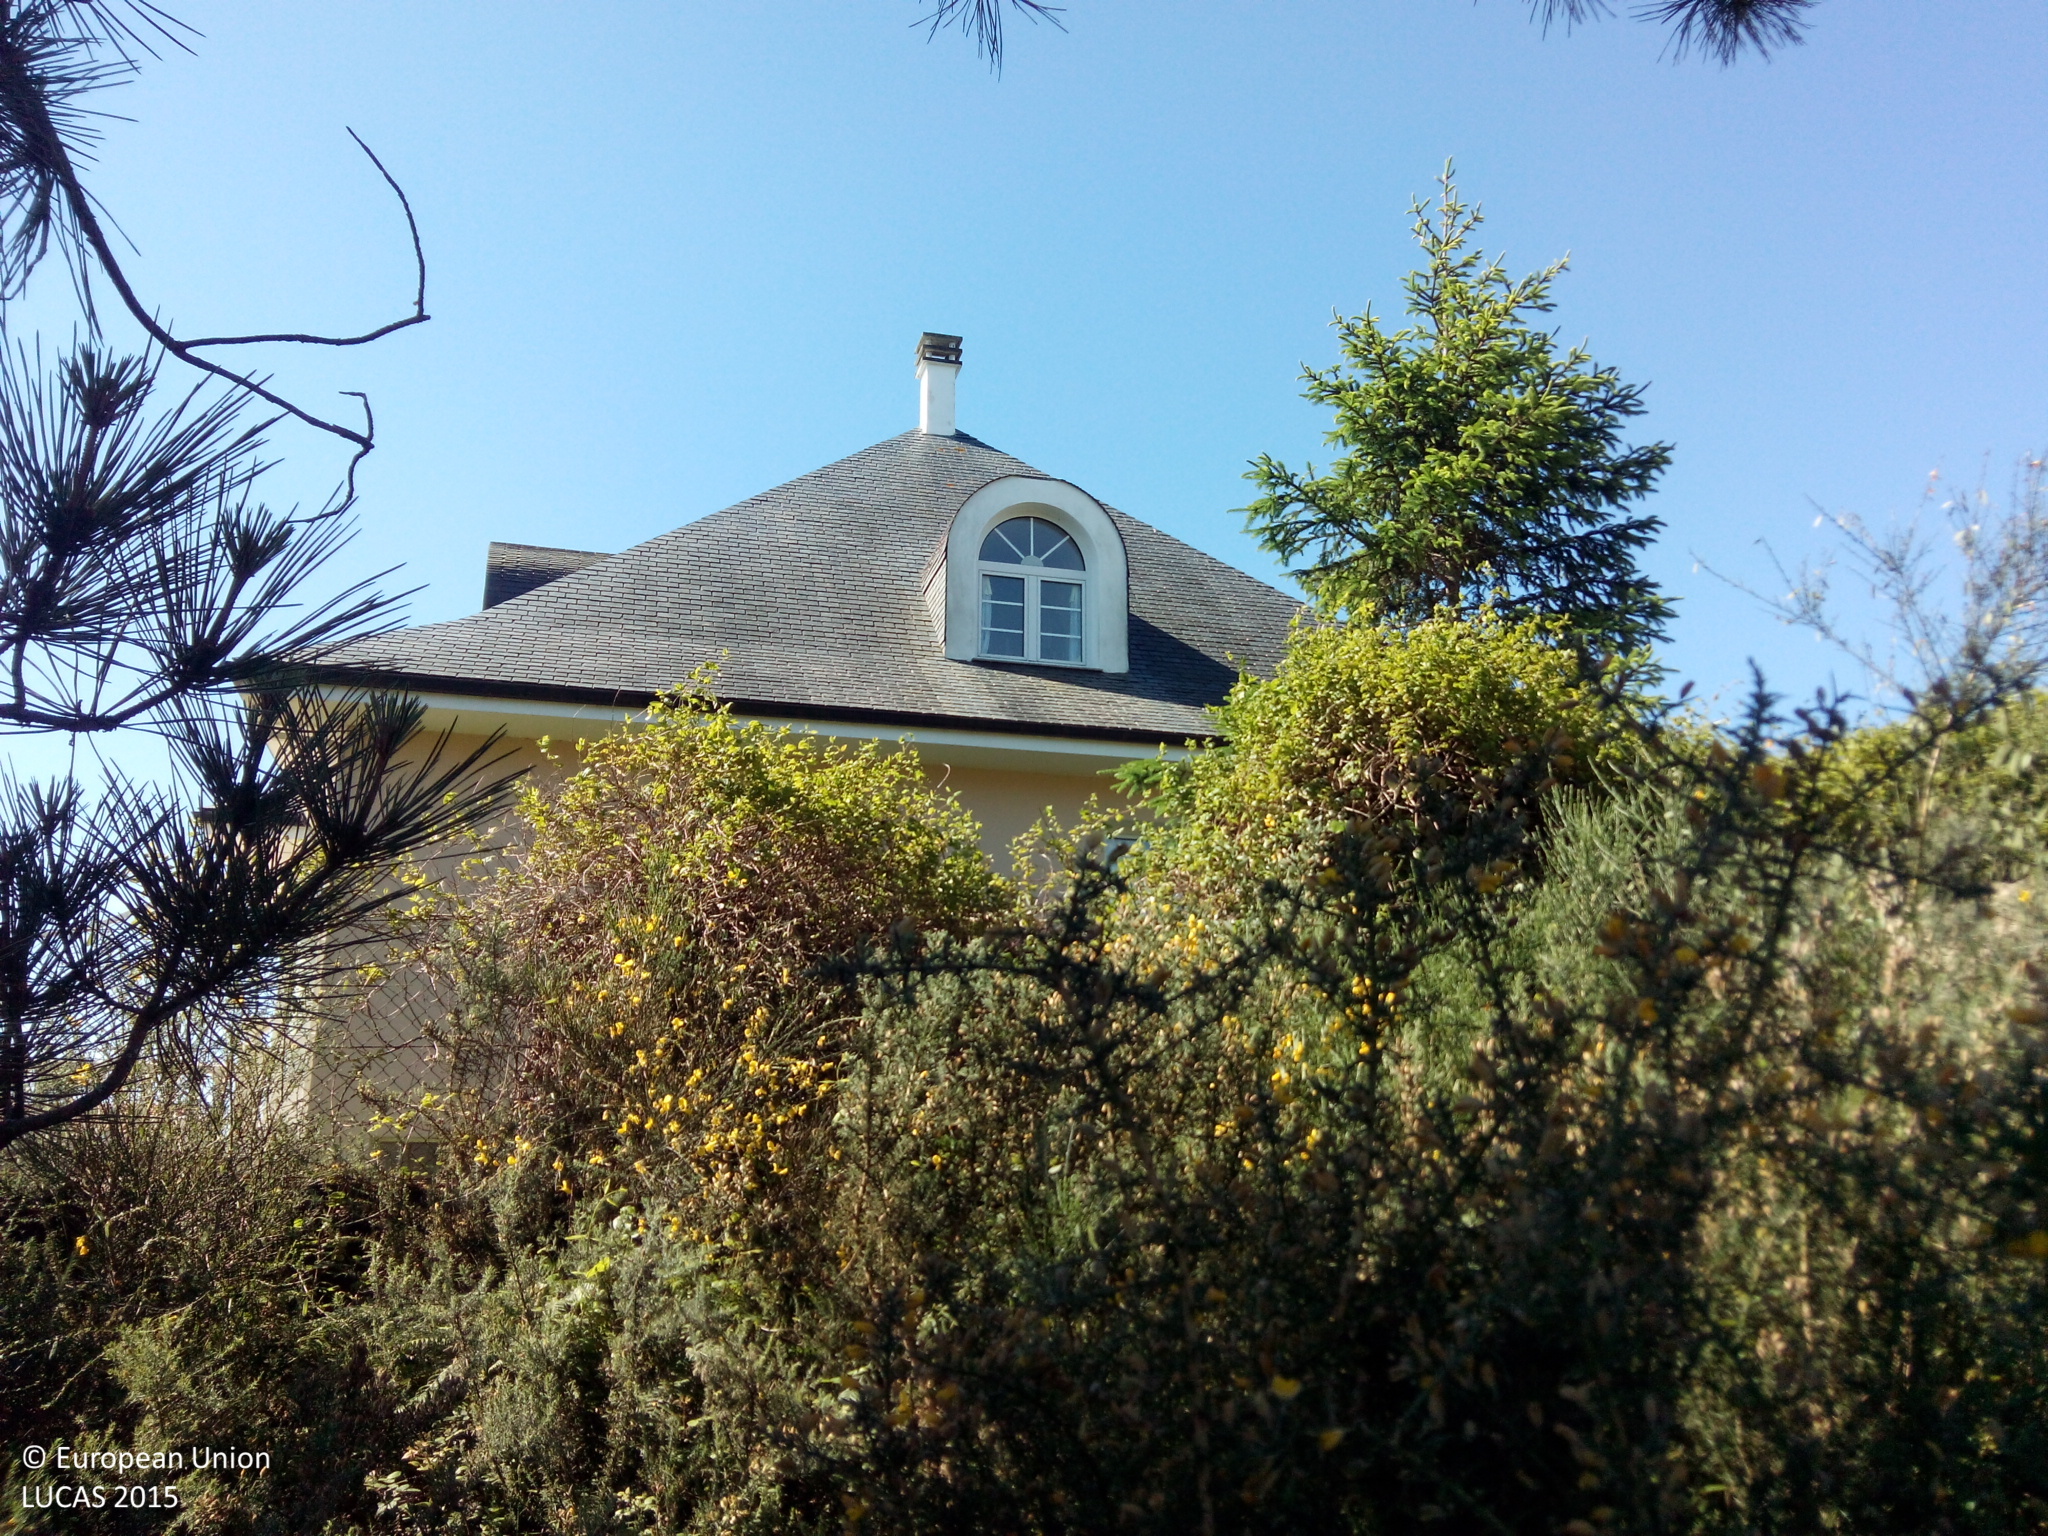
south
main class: Shrubland
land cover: Shrubland without tree cover
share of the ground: > 75 %
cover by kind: shrubs 100 %
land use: Semi-natural and natural areas not in use
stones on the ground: < 10 %
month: May
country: ES
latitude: 42.5555
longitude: -9.0051
